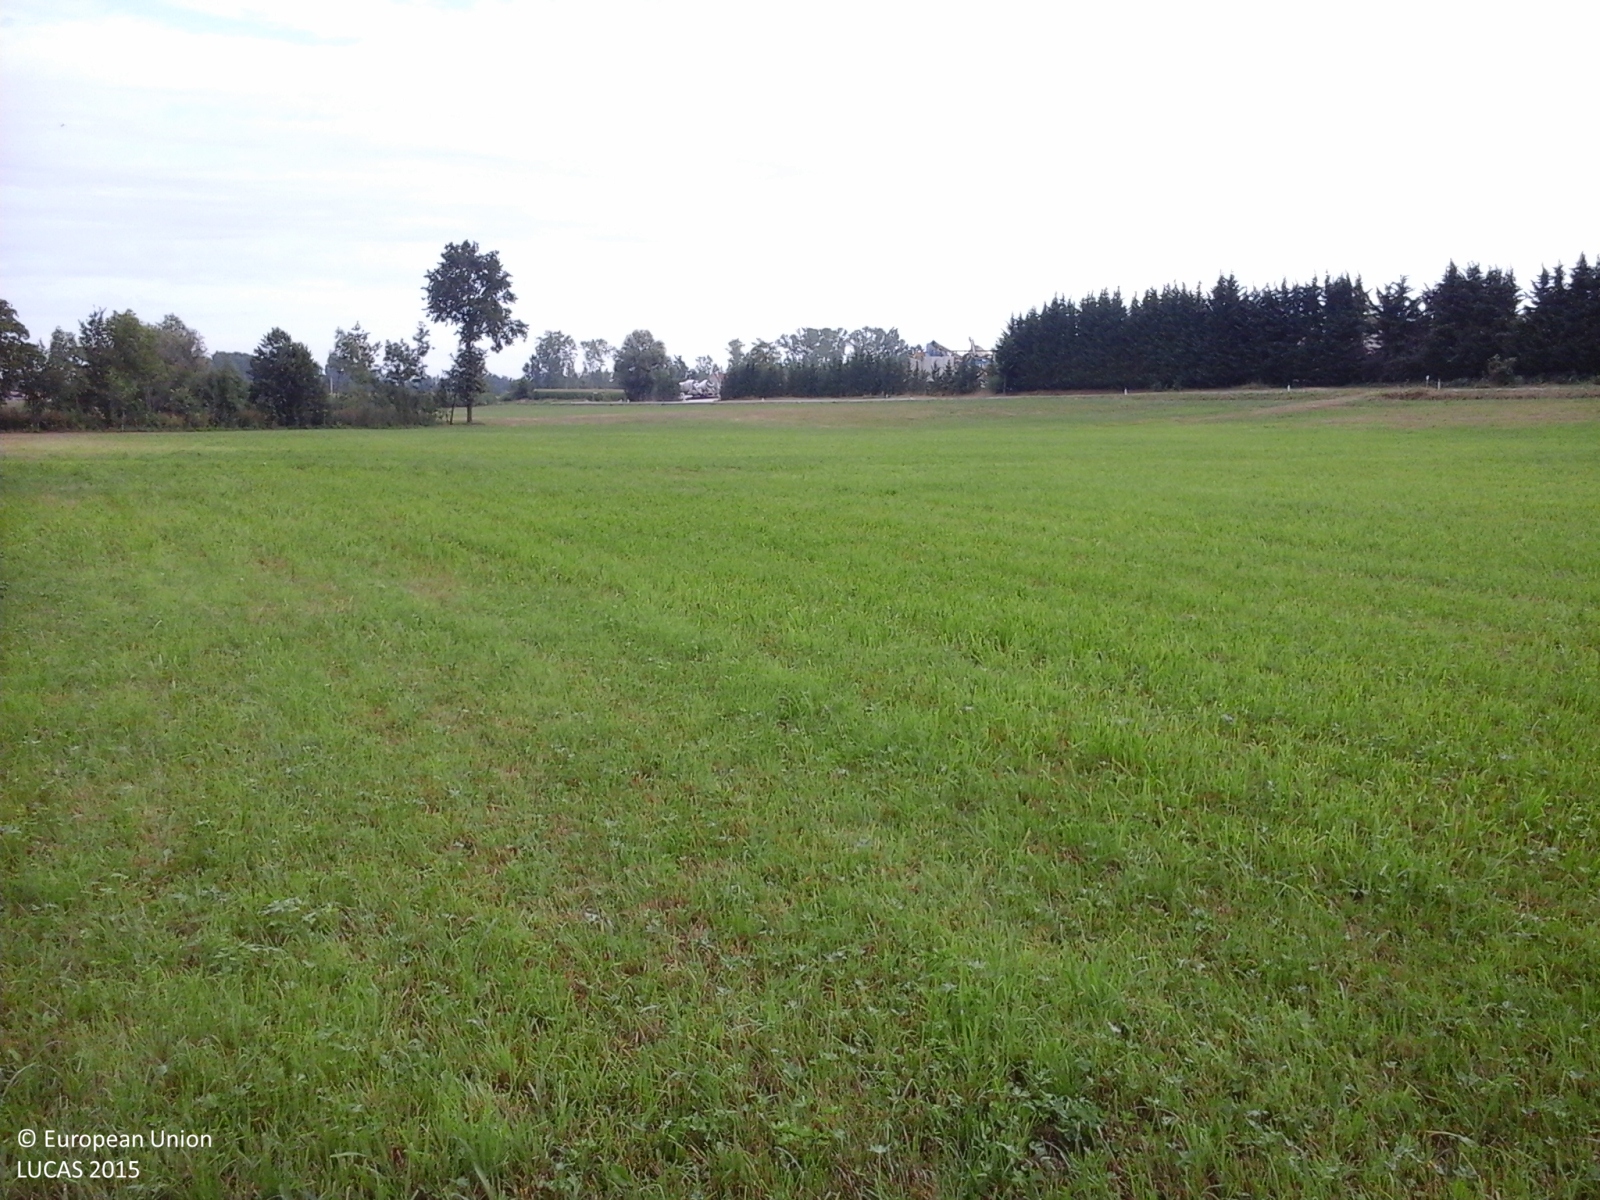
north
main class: Grassland
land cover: Grassland without tree/shrub cover
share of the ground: > 75 %
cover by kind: herbaceous plants 100 %
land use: Agriculture (excluding fallow land and kitchen gardens)
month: July
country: IT
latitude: 44.3422
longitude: 7.6594
